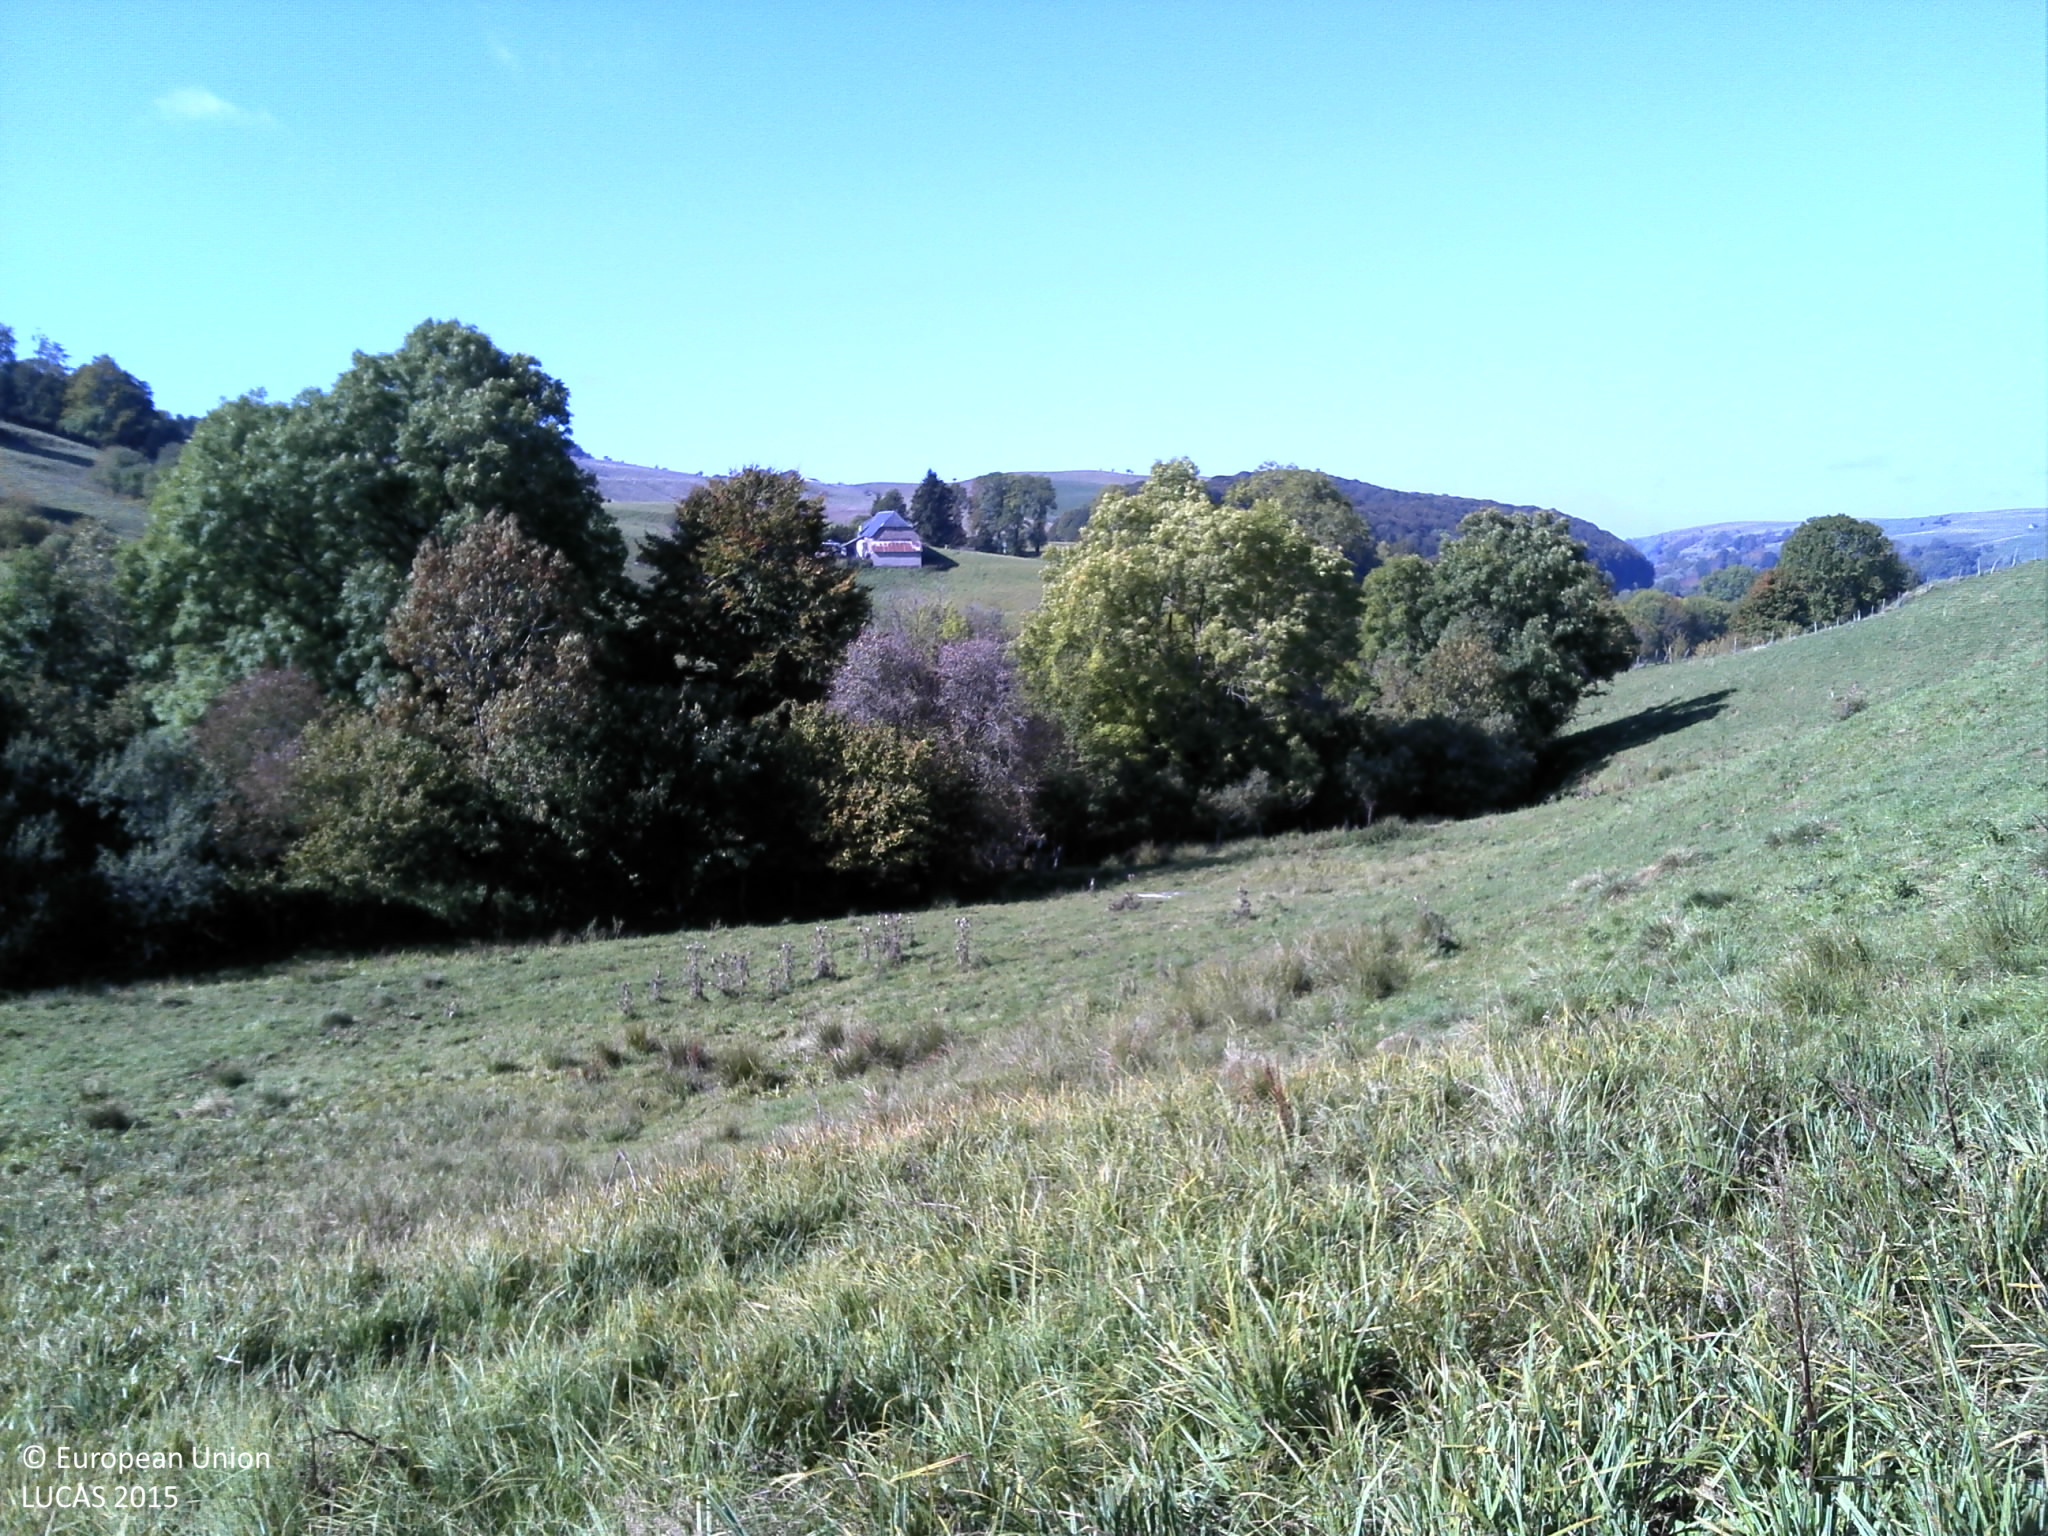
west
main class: Grassland
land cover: Grassland without tree/shrub cover
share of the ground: > 75 %
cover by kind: herbaceous plants 100 %
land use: Agriculture (excluding fallow land and kitchen gardens)
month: October
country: FR
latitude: 45.3909
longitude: 2.8858
